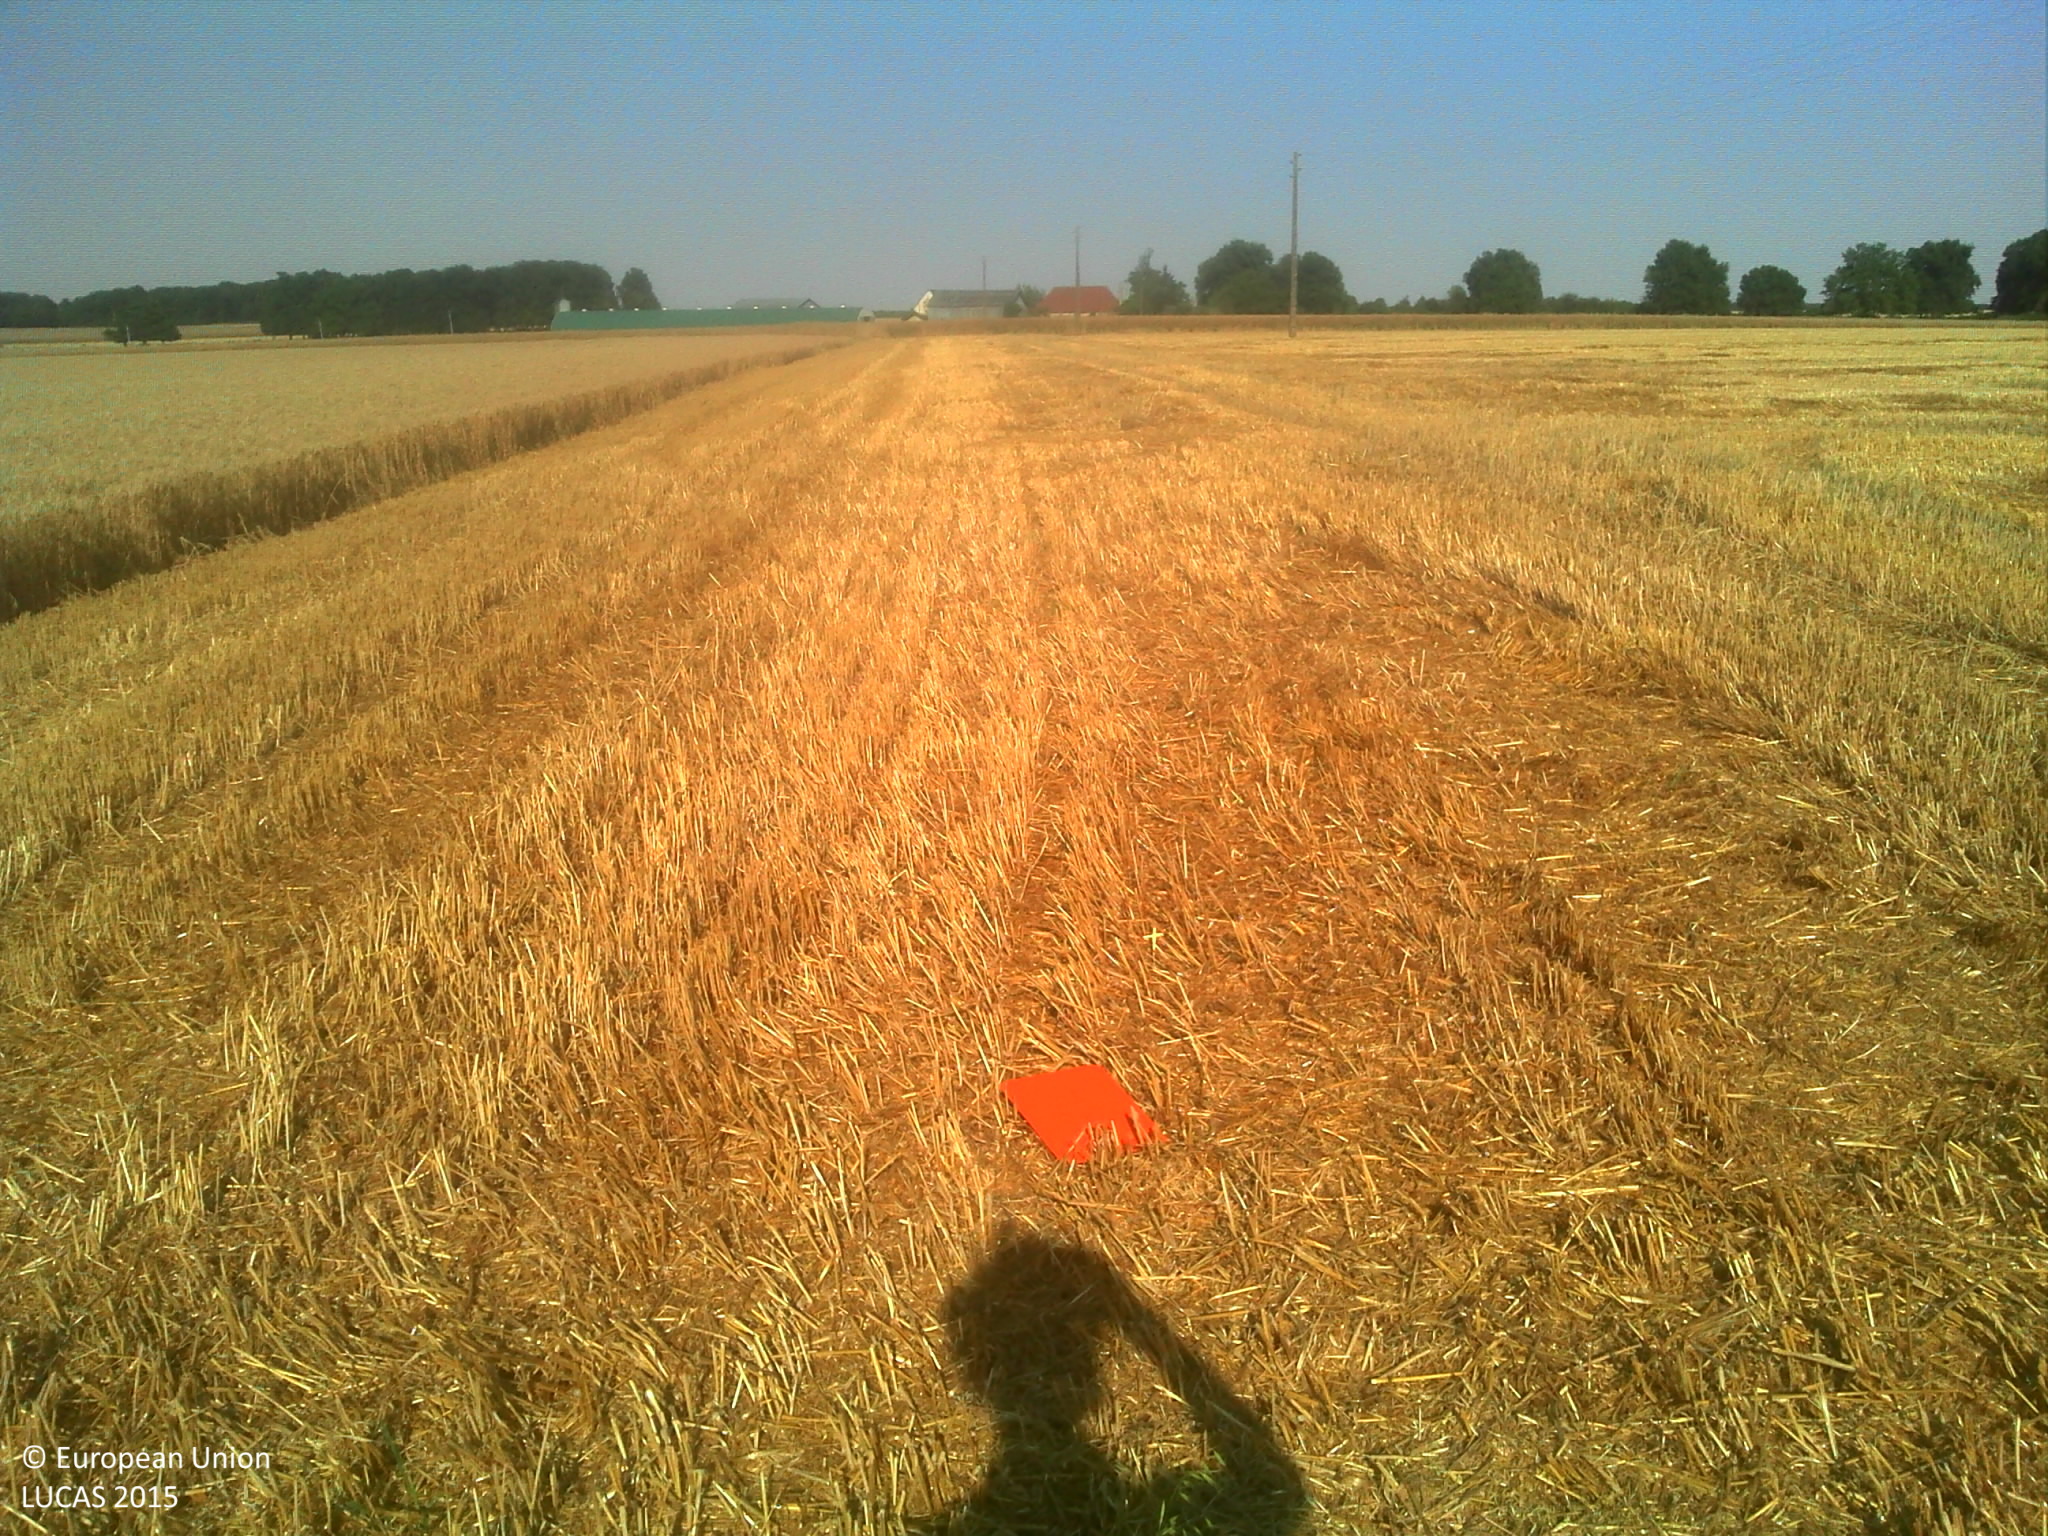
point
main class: Cropland
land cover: Common wheat
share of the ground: > 75 %
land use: Agriculture (excluding fallow land and kitchen gardens)
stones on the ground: < 10 %
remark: Harvested field
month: July
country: FR
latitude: 47.6998
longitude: 0.6645
